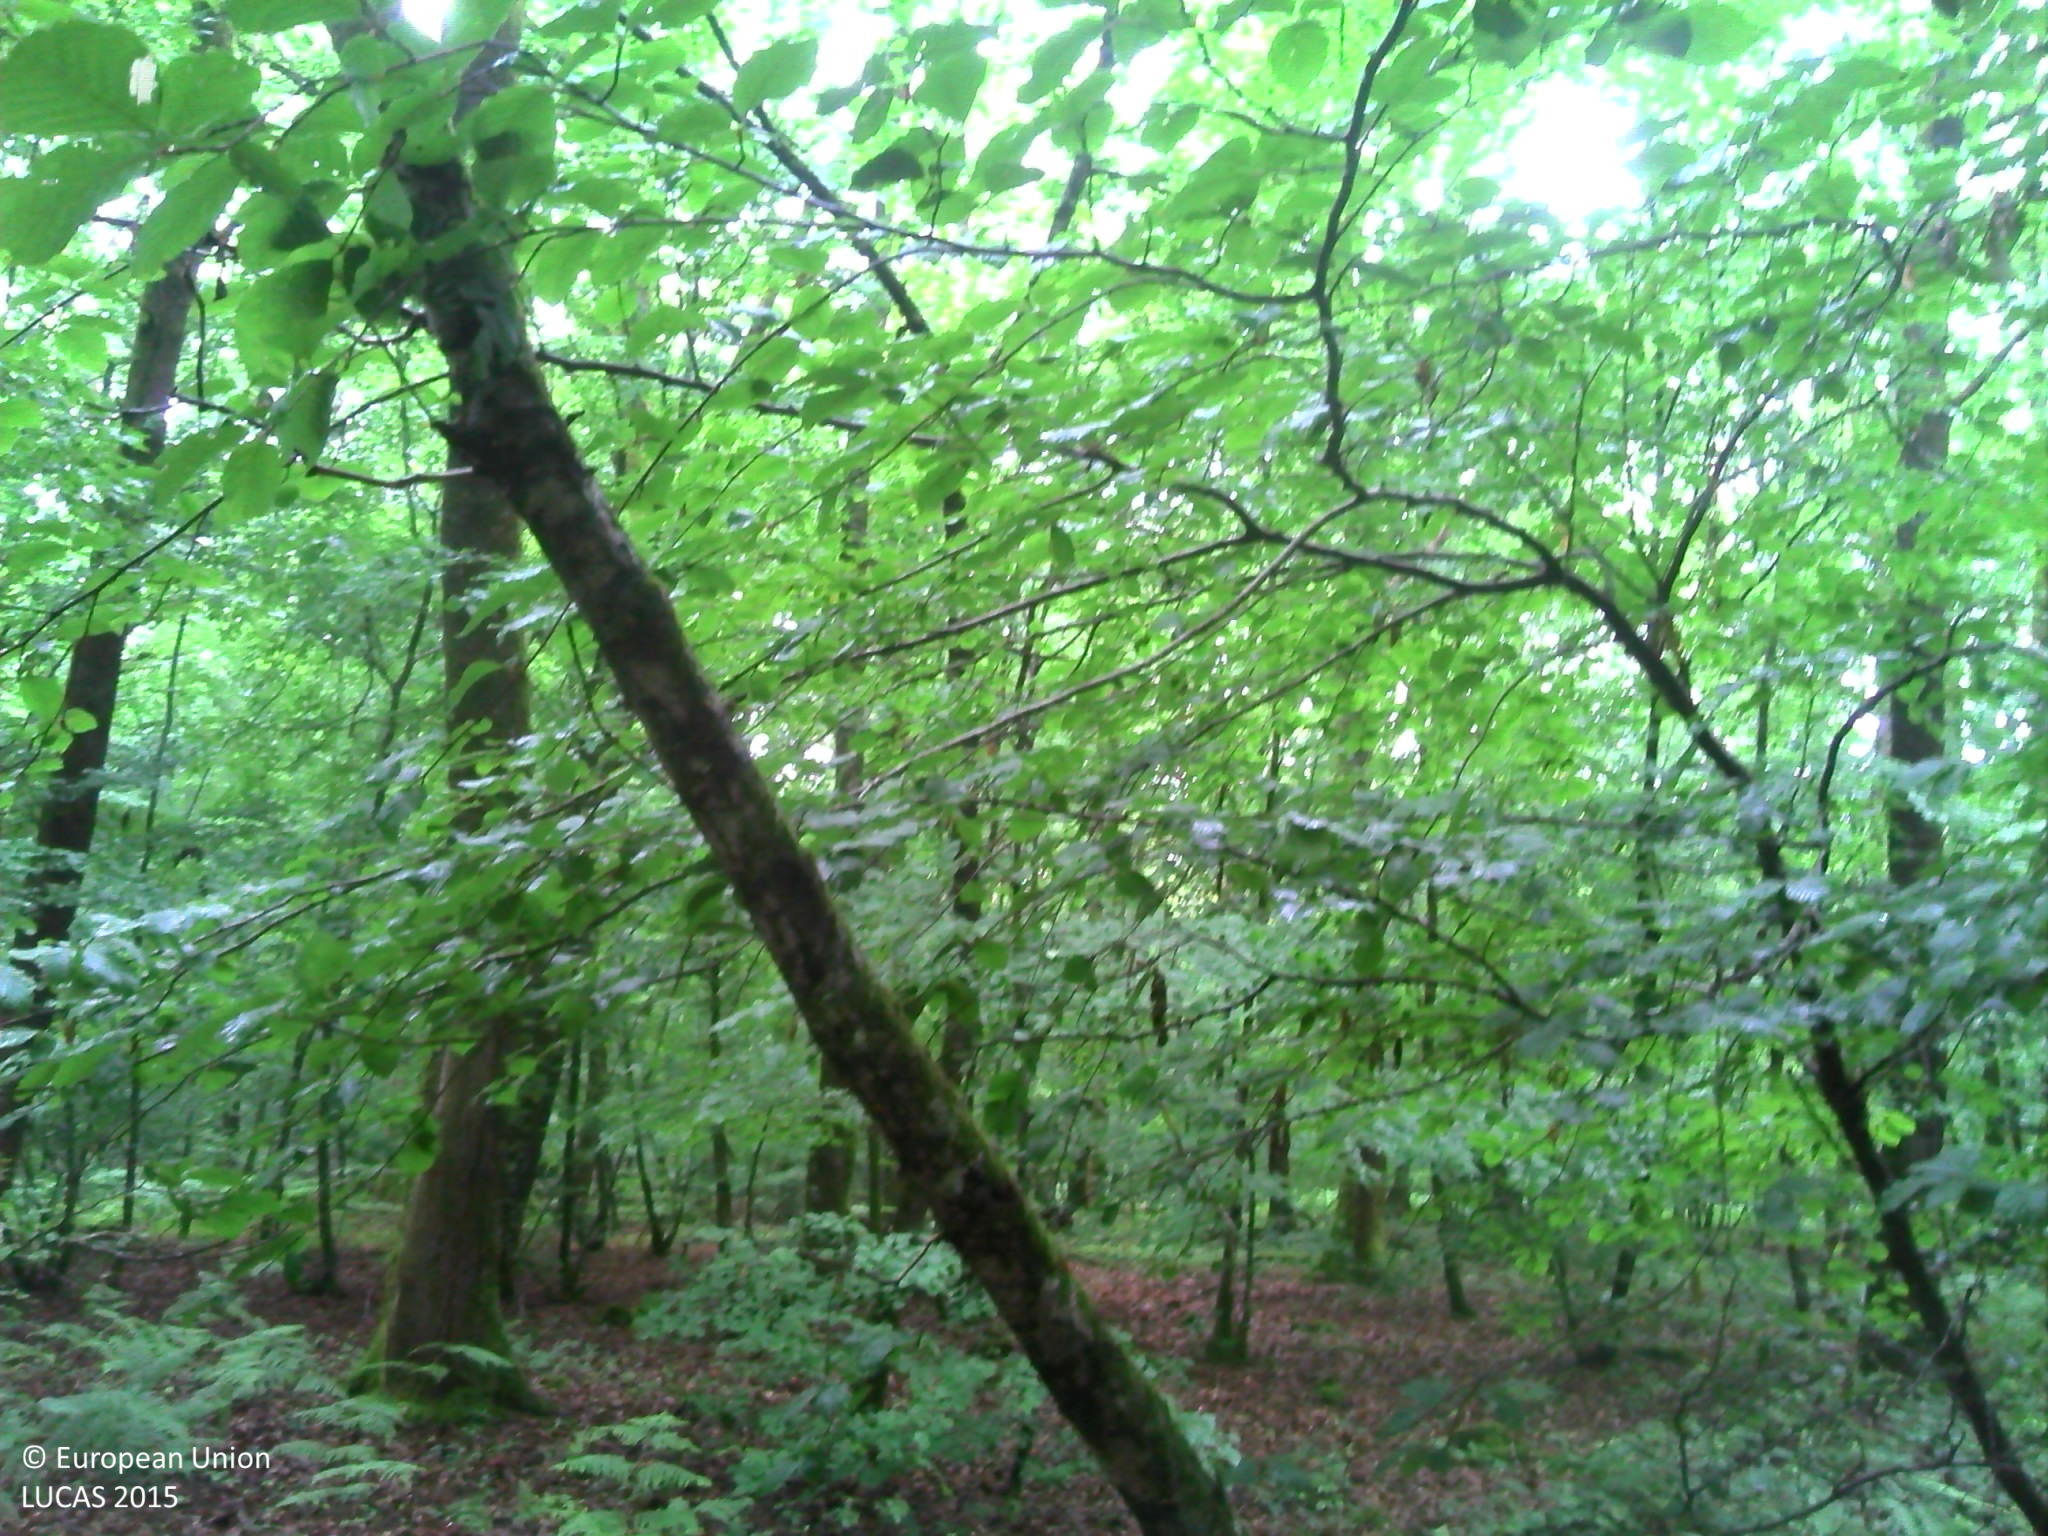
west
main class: Woodland
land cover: Broadleaved woodland
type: acidophilous oak and oak-birch forest
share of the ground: > 75 %
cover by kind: broadleaved forest trees 95 %, lichens and mosses 5 %
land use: Forestry
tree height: > 5 m
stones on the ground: < 10 %
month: June
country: FR
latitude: 47.2560
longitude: 3.2169
